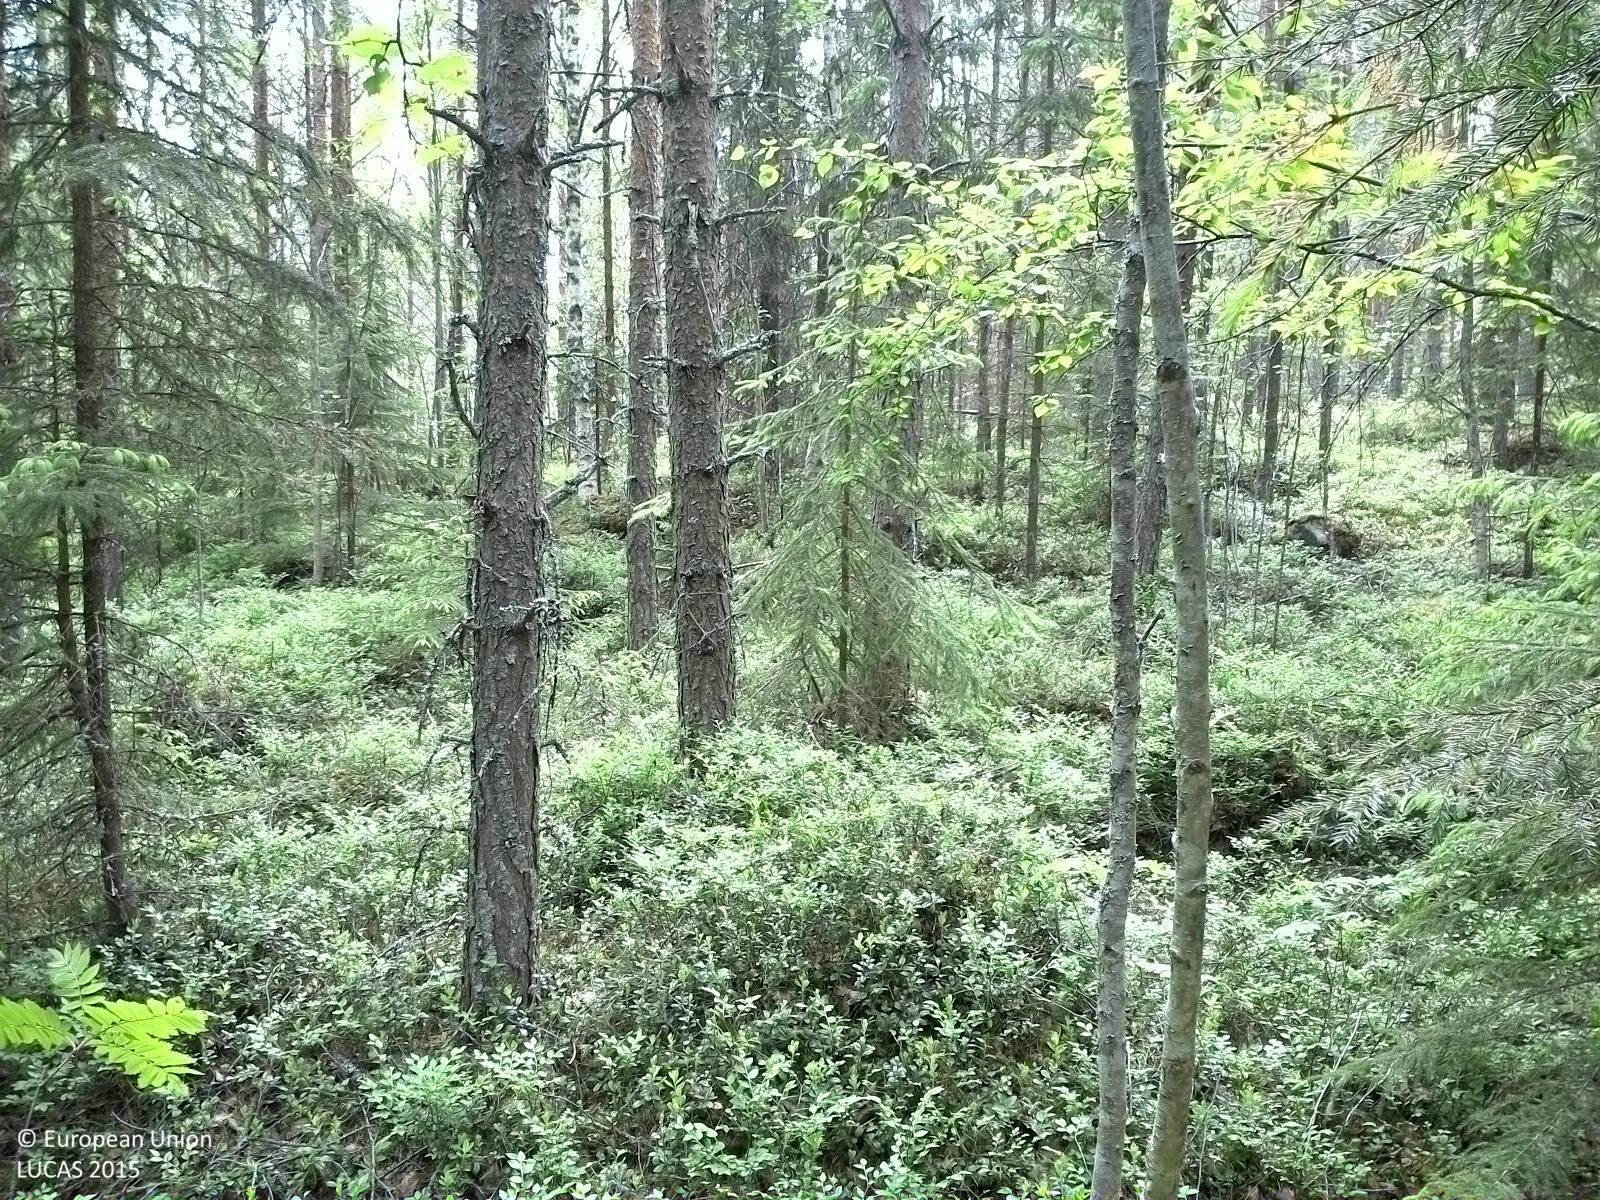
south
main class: Woodland
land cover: Pine dominated mixed woodland
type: boreal forest
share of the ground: 50 - 75 %
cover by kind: coniferous forest trees 35 %, shrubs 30 %, broadleaved forest trees 25 %, lichens and mosses 10 %
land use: Forestry
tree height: > 5 m
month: June
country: SE
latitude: 62.0491
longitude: 16.2351
